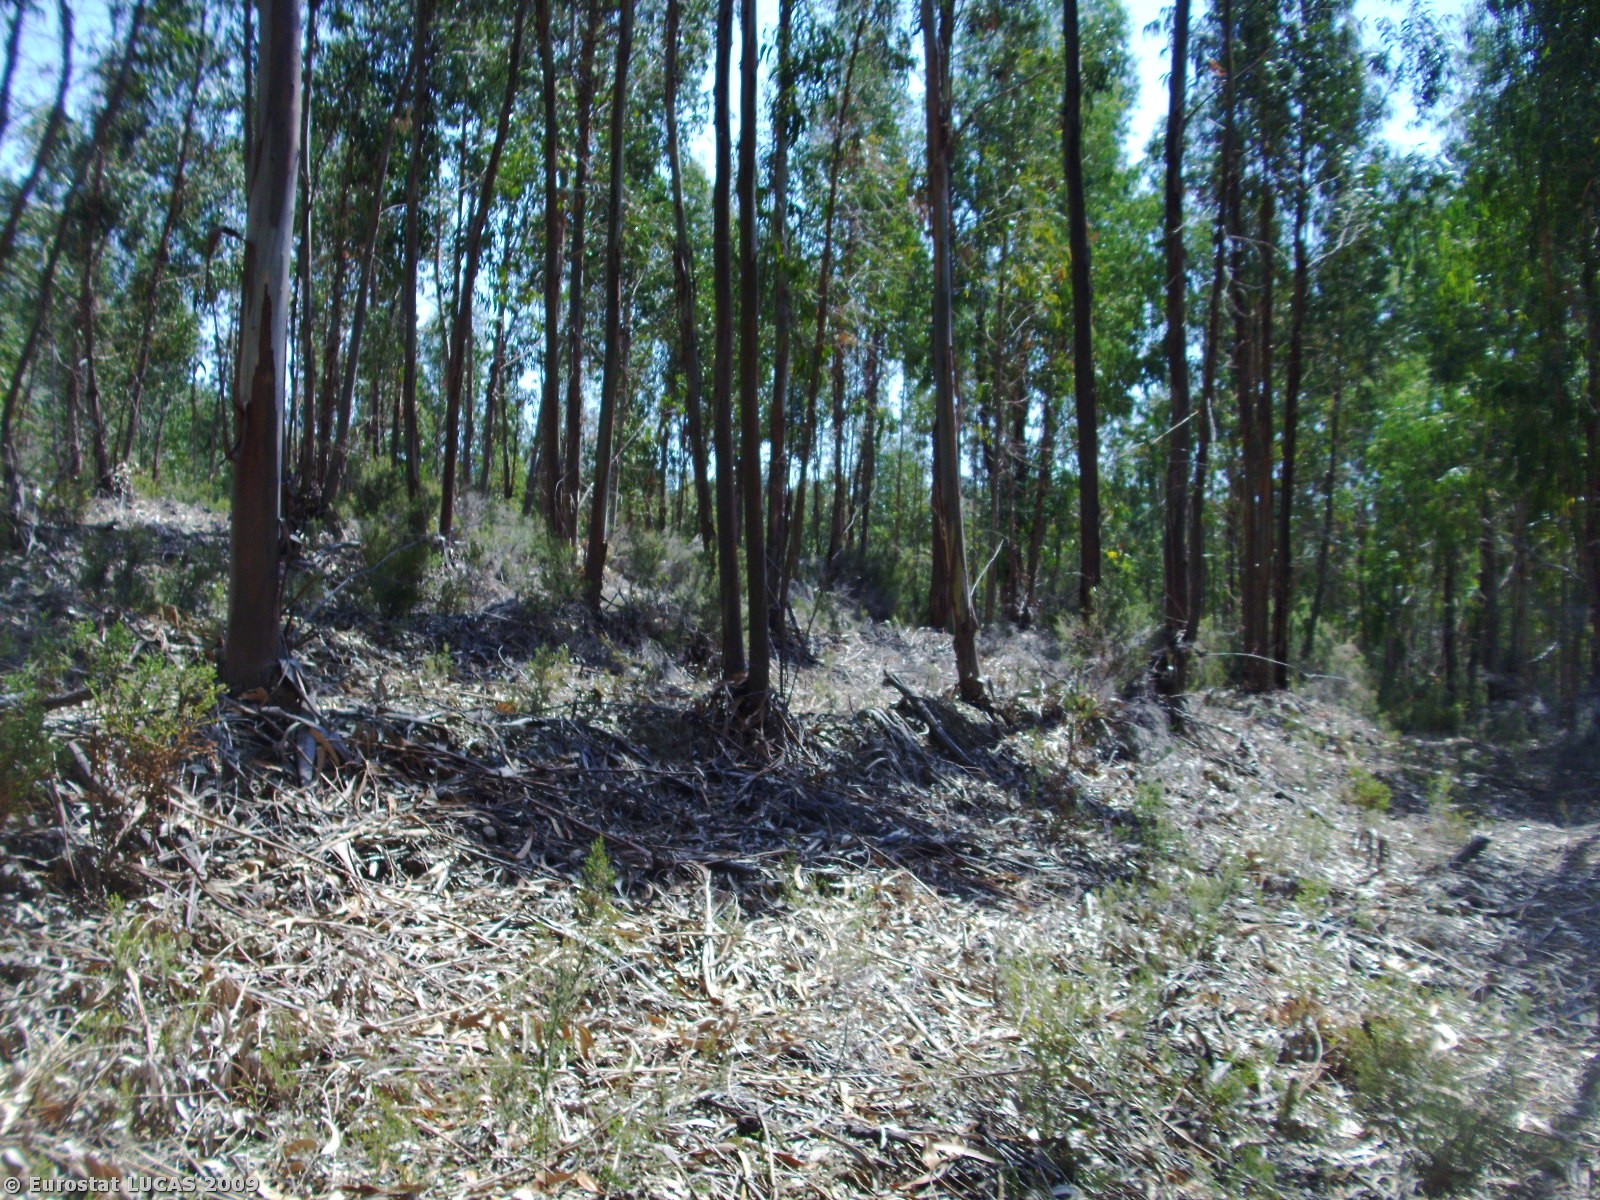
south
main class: Woodland
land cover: Broadleaved woodland
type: plantations and self-sown exotic forest
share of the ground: > 75 %
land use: Forestry
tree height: > 5 m
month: August
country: PT
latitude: 40.1553
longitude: -7.6121
